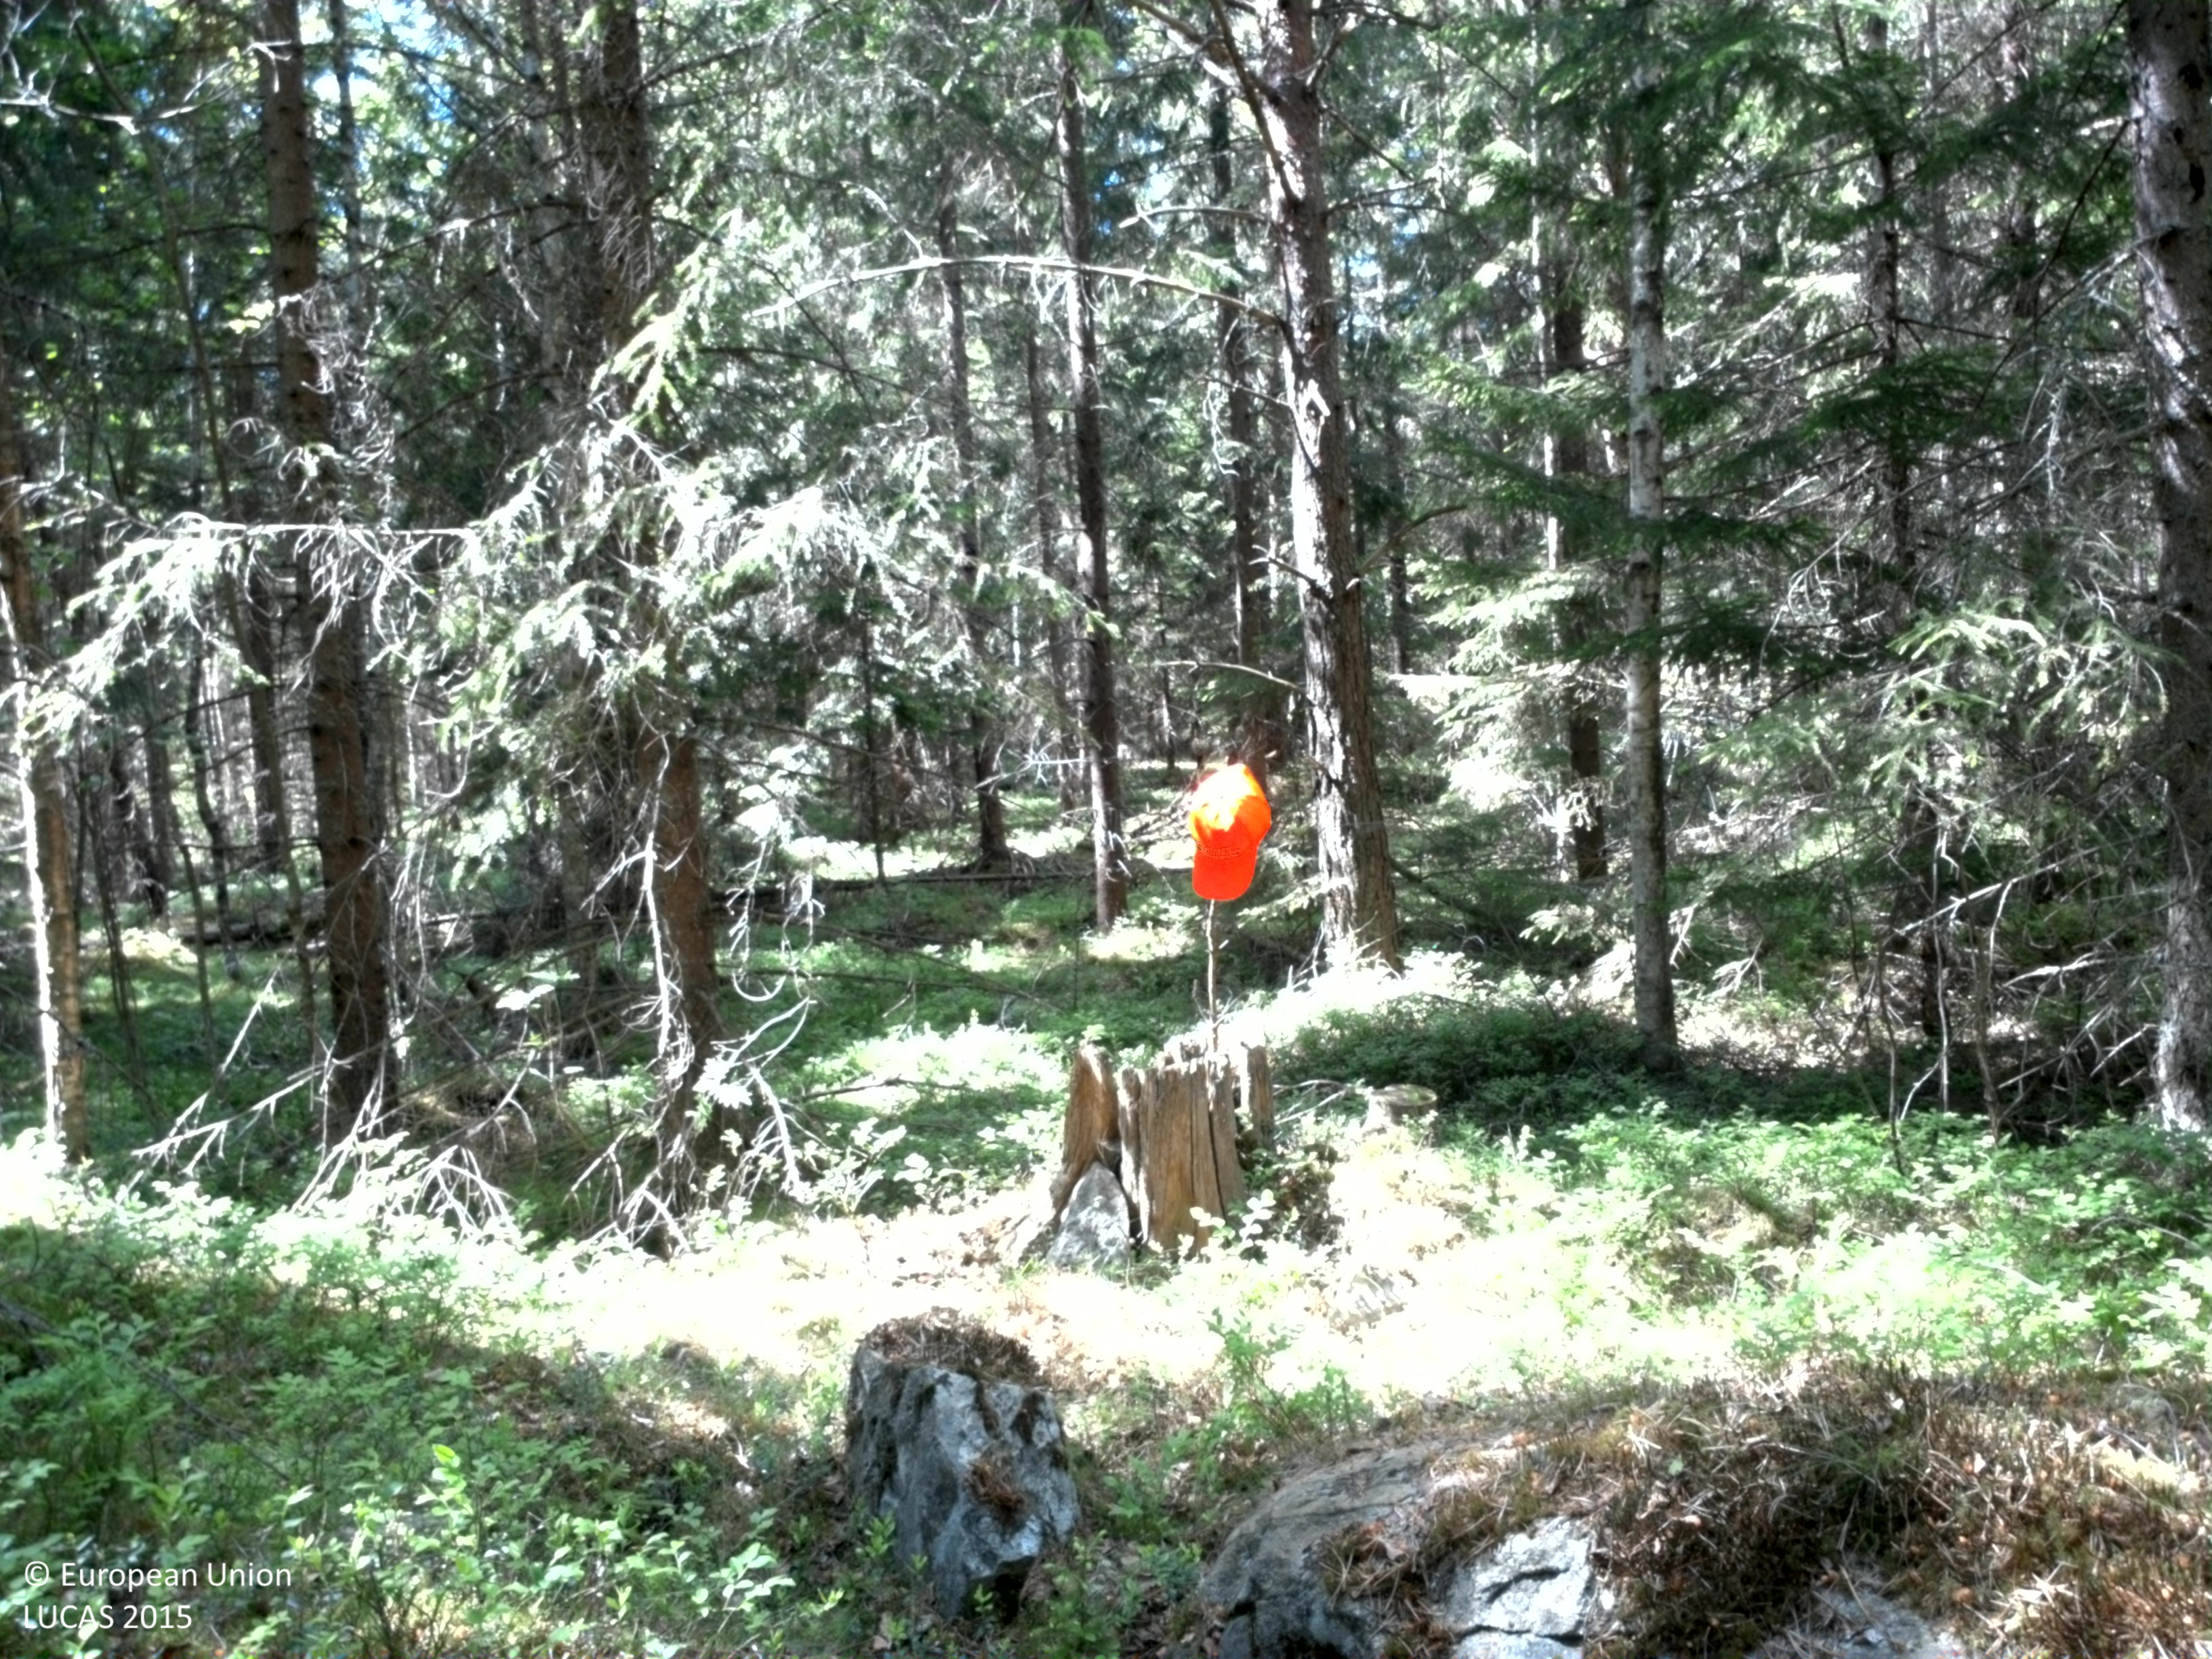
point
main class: Woodland
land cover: Spruce dominated mixed woodland
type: boreal forest
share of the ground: > 75 %
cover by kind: coniferous forest trees 65 %, broadleaved forest trees 25 %, shrubs 10 %
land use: Forestry
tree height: > 5 m
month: June
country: SE
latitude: 59.2273
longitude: 13.1296
